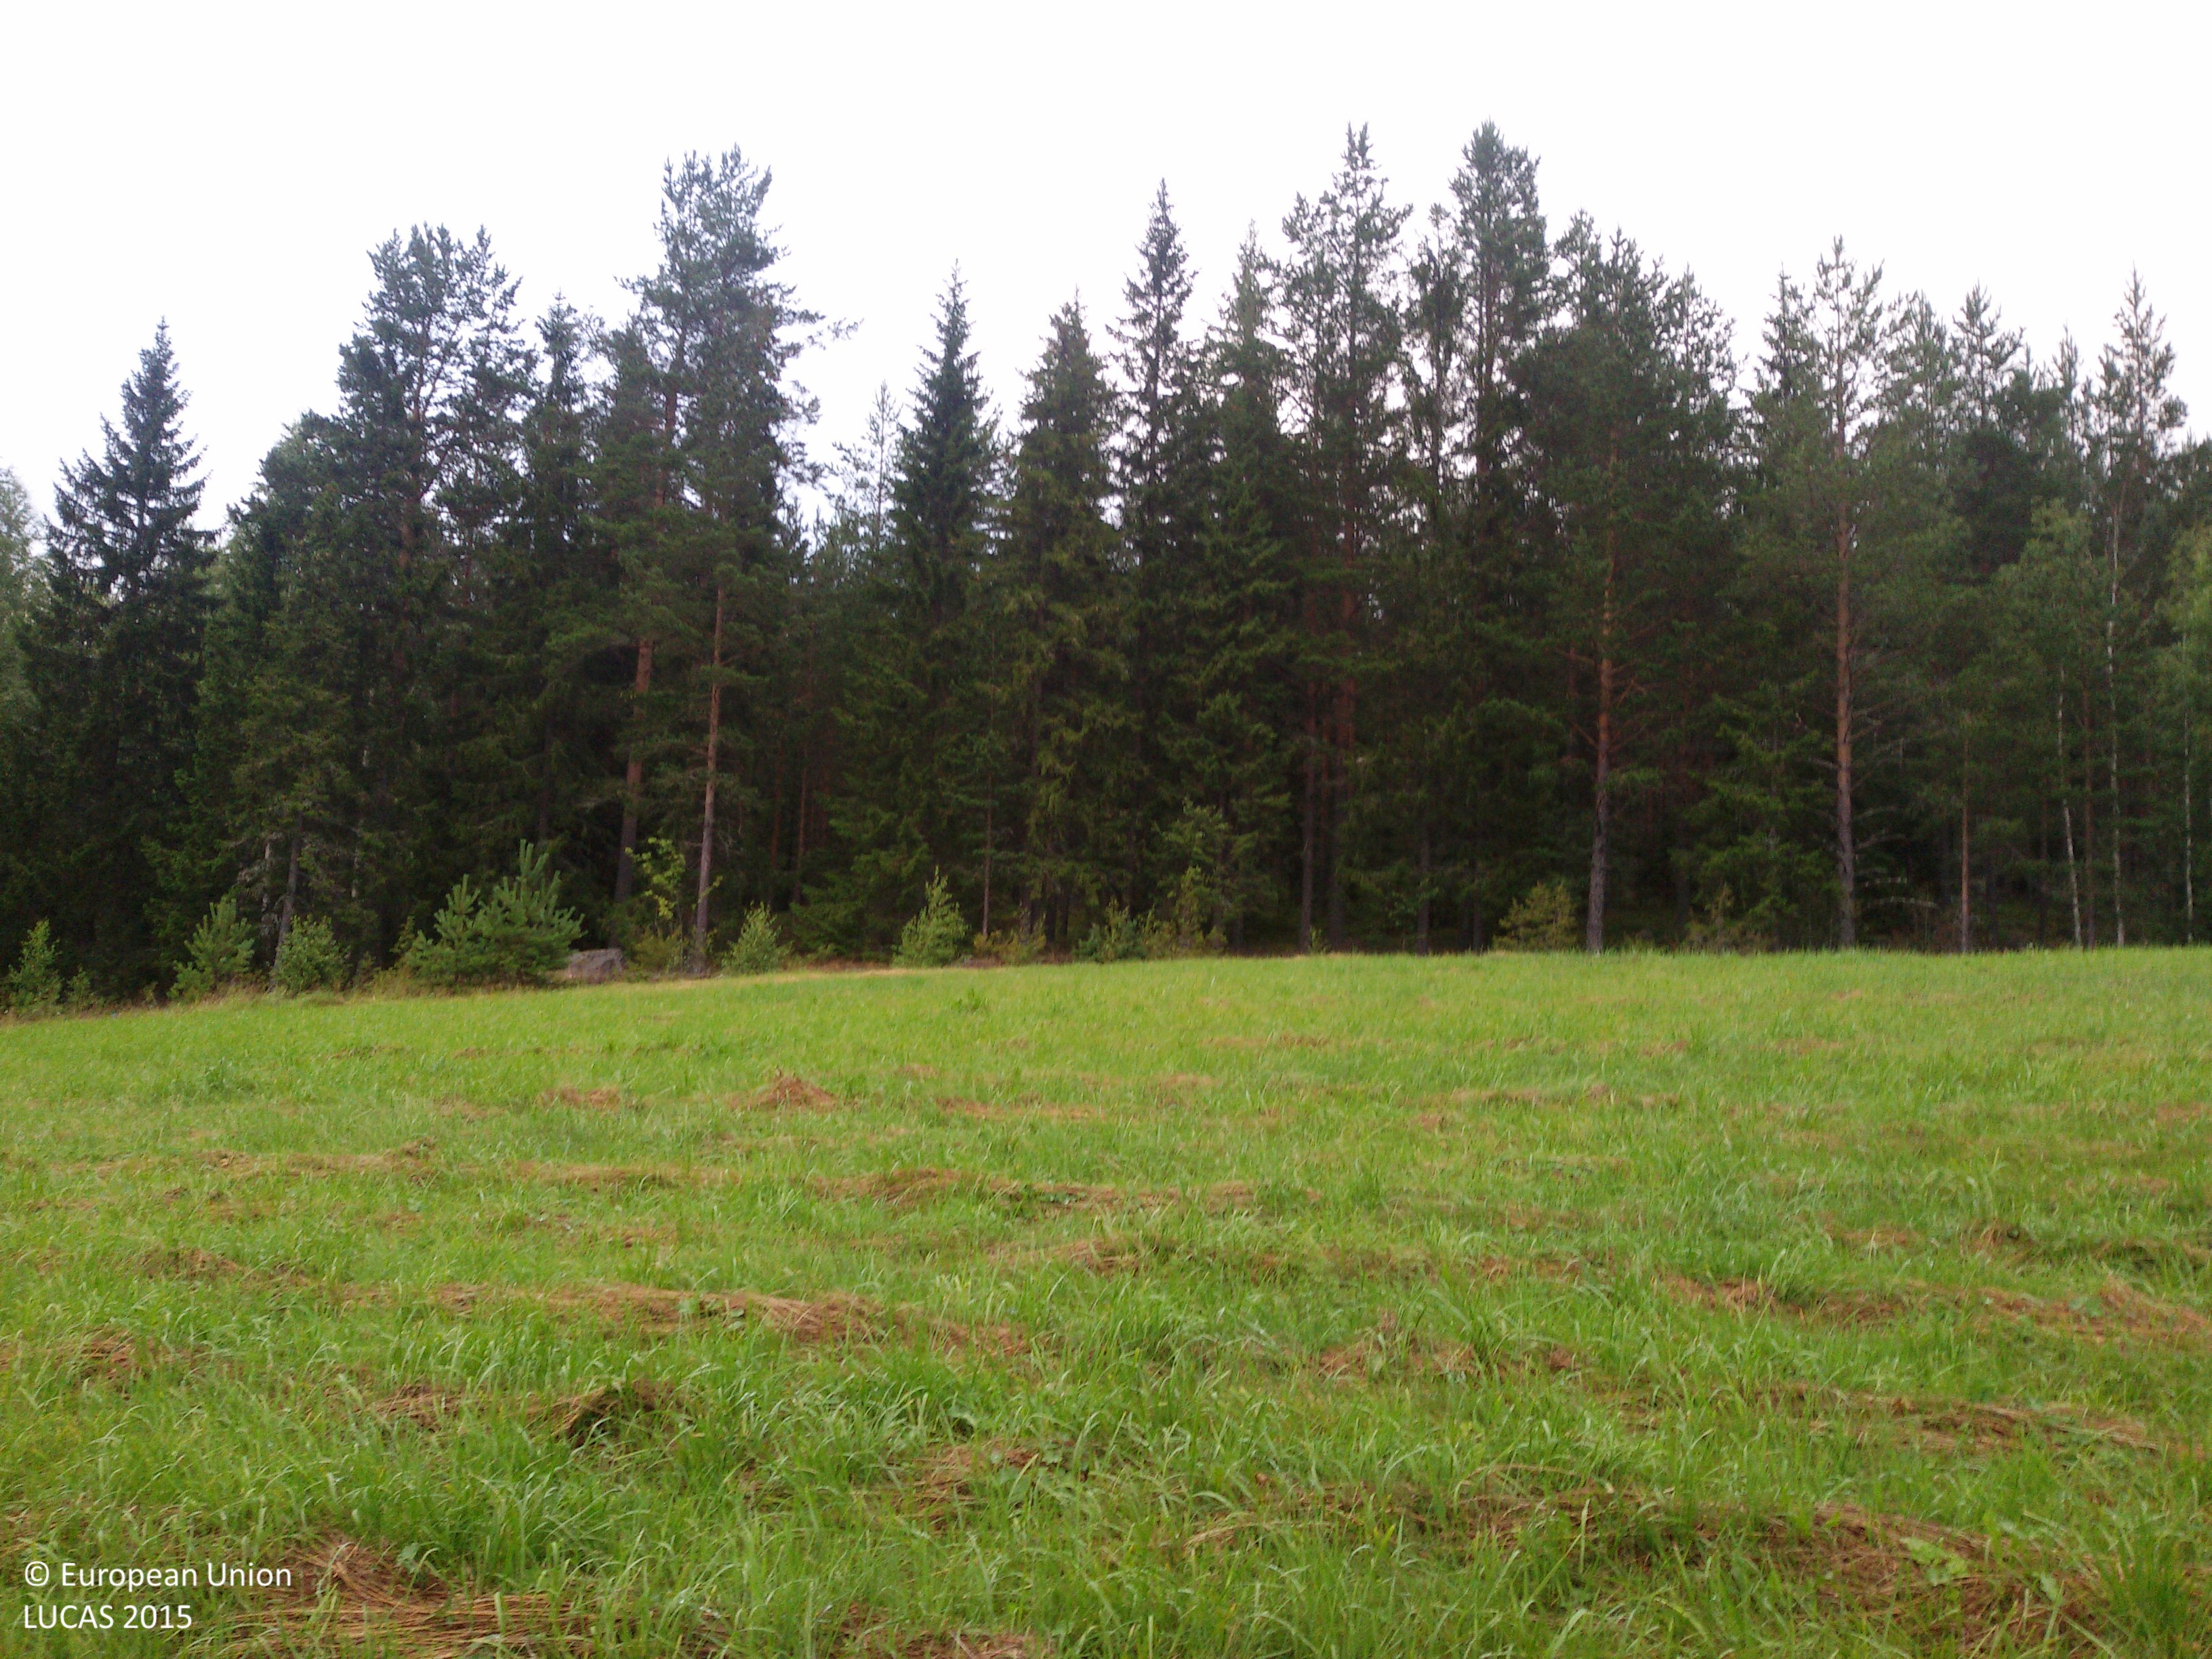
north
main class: Grassland
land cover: Grassland without tree/shrub cover
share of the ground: > 75 %
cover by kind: herbaceous plants 100 %
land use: Agriculture (excluding fallow land and kitchen gardens)
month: August
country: SE
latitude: 60.9149
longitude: 16.5336
